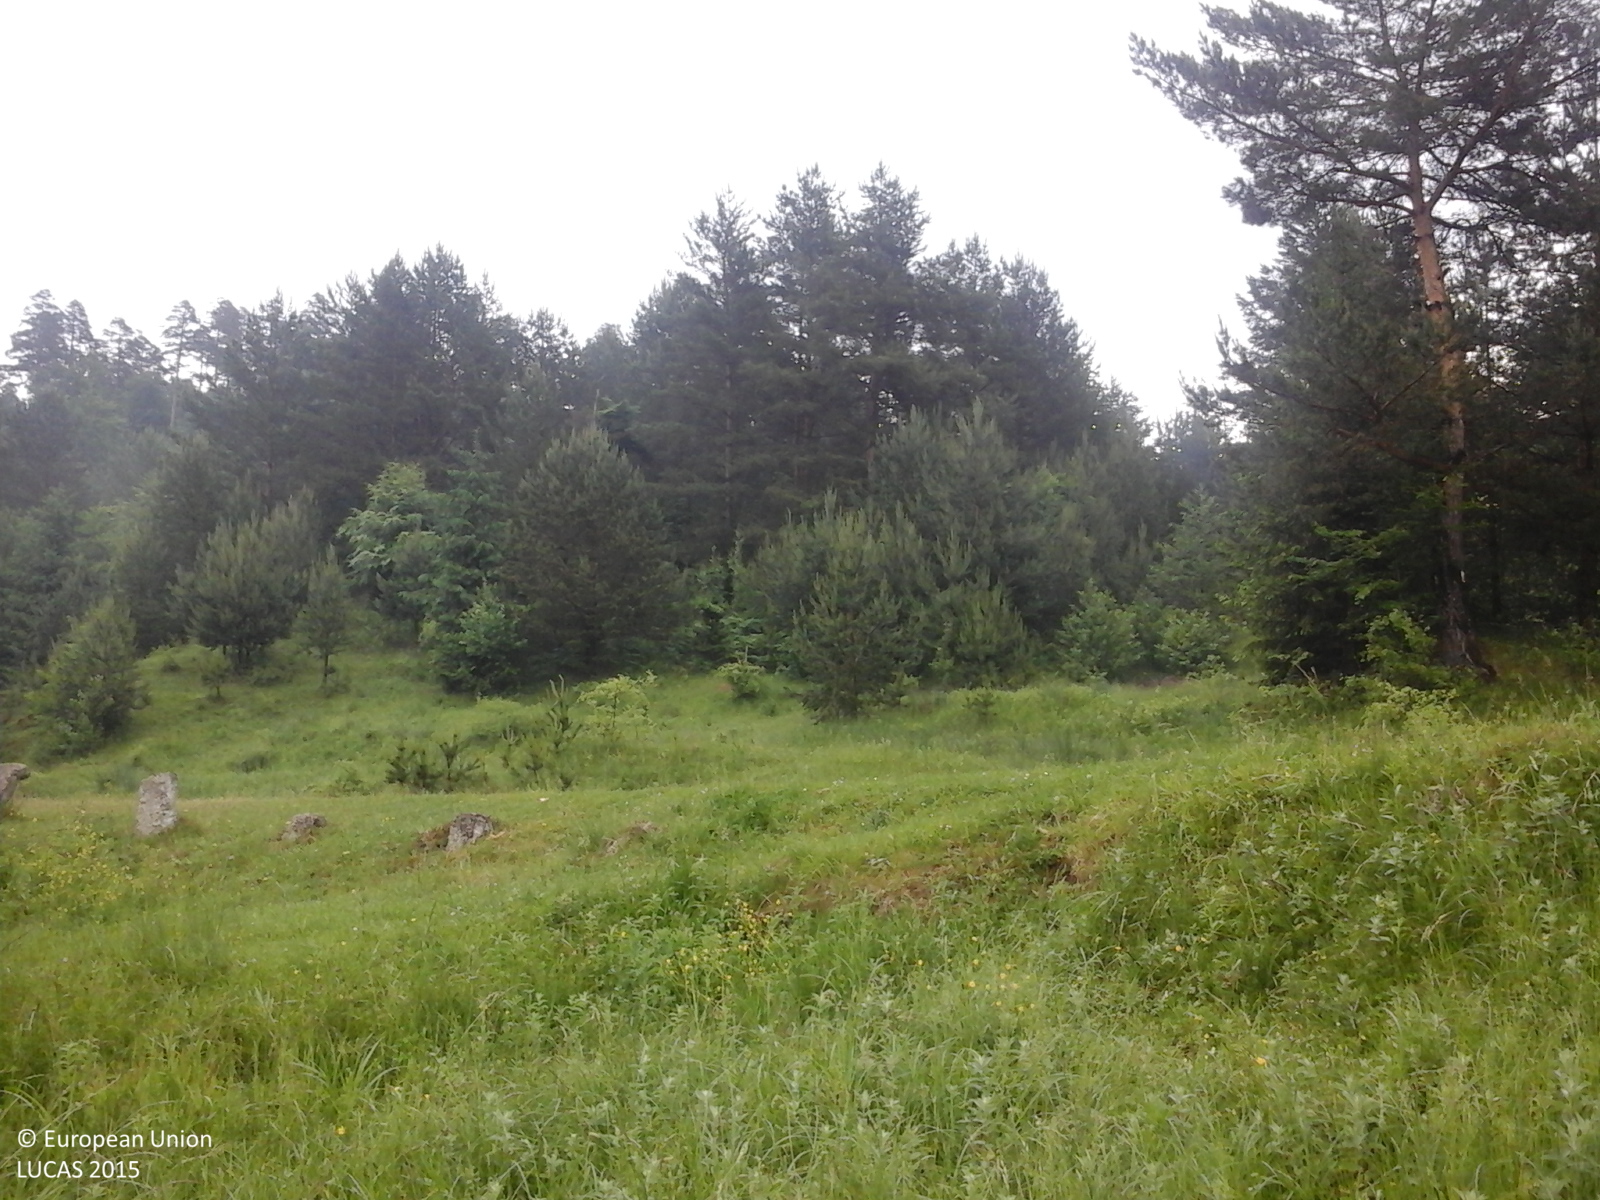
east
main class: Grassland
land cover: Grassland without tree/shrub cover
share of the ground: > 75 %
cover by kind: herbaceous plants 100 %
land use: Agriculture (excluding fallow land and kitchen gardens)
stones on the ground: < 10 %
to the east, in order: Grassland without tree/shrub cover; Tracks; Grassland with sparse tree/shrub cover; Spruce dominated coniferous woodland; Grassland with sparse tree/shrub cover
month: June
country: RO
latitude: 46.4100
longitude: 26.4316
